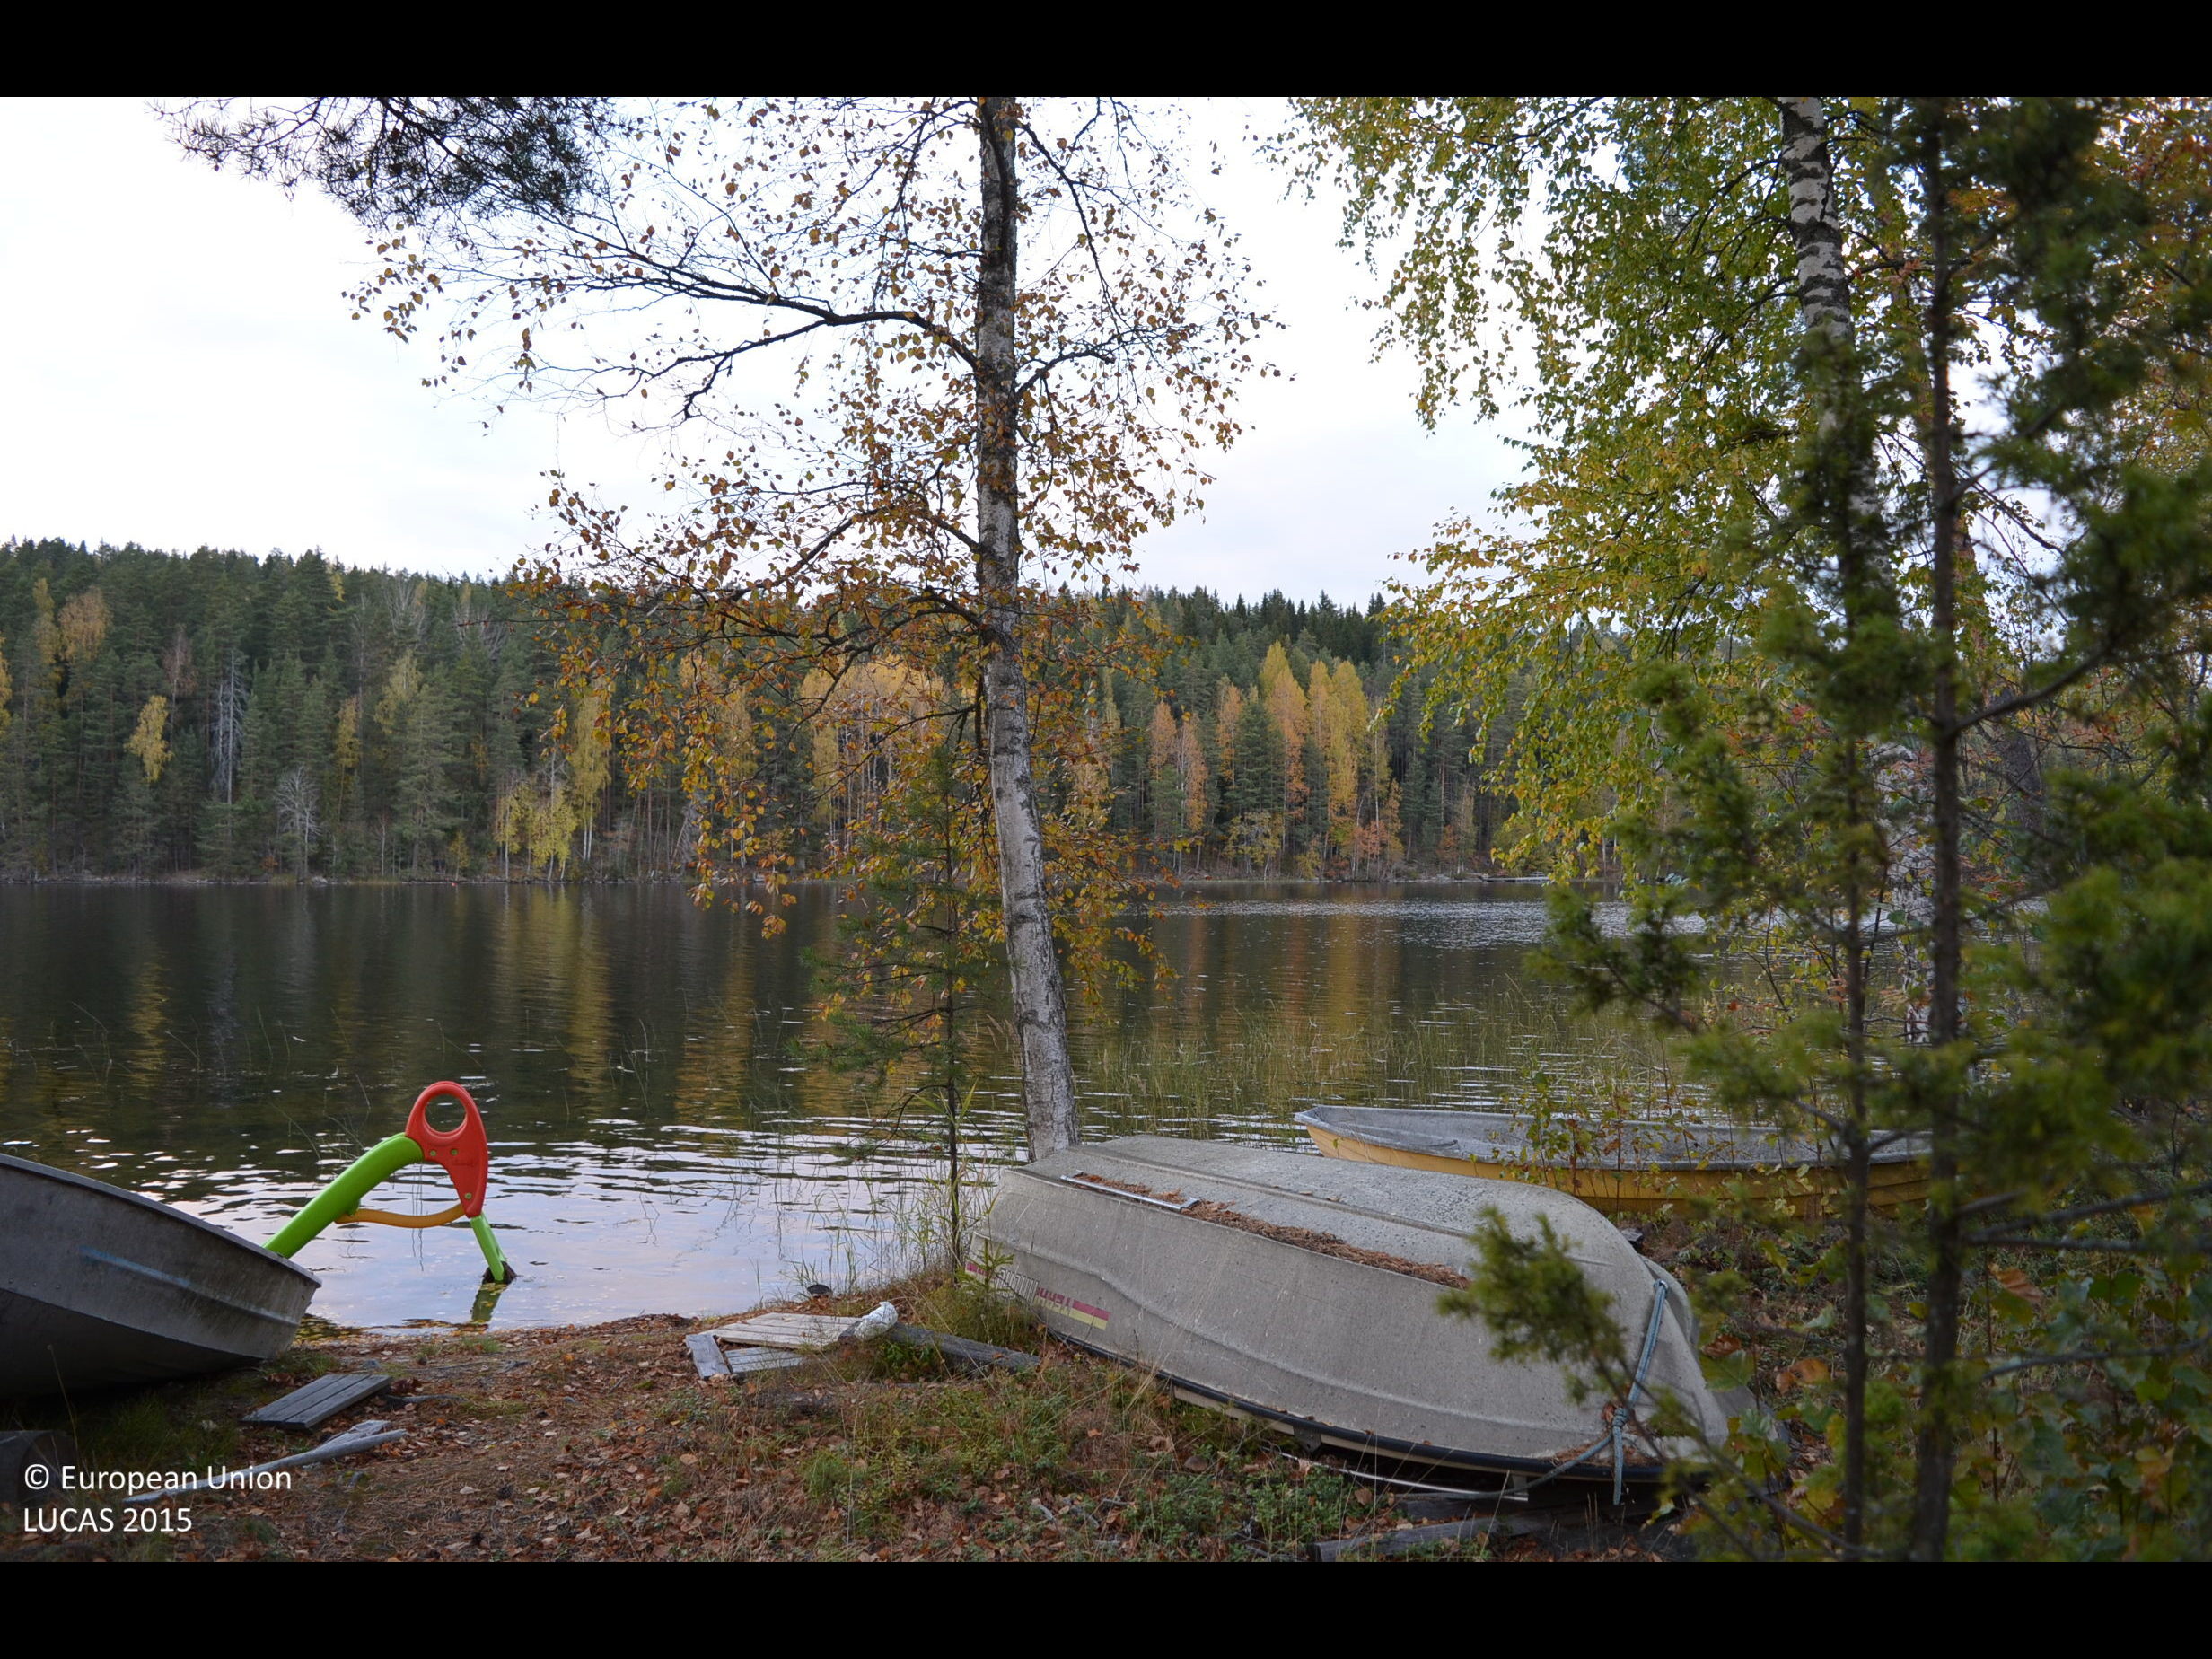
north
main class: Woodland
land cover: Other mixed woodland
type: boreal forest
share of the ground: 50 - 75 %
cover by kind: herbaceous plants 40 %, coniferous forest trees 25 %, broadleaved forest trees 25 %, shrubs 10 %
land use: Residential
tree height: > 5 m
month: October
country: FI
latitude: 61.6351
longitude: 23.8781
